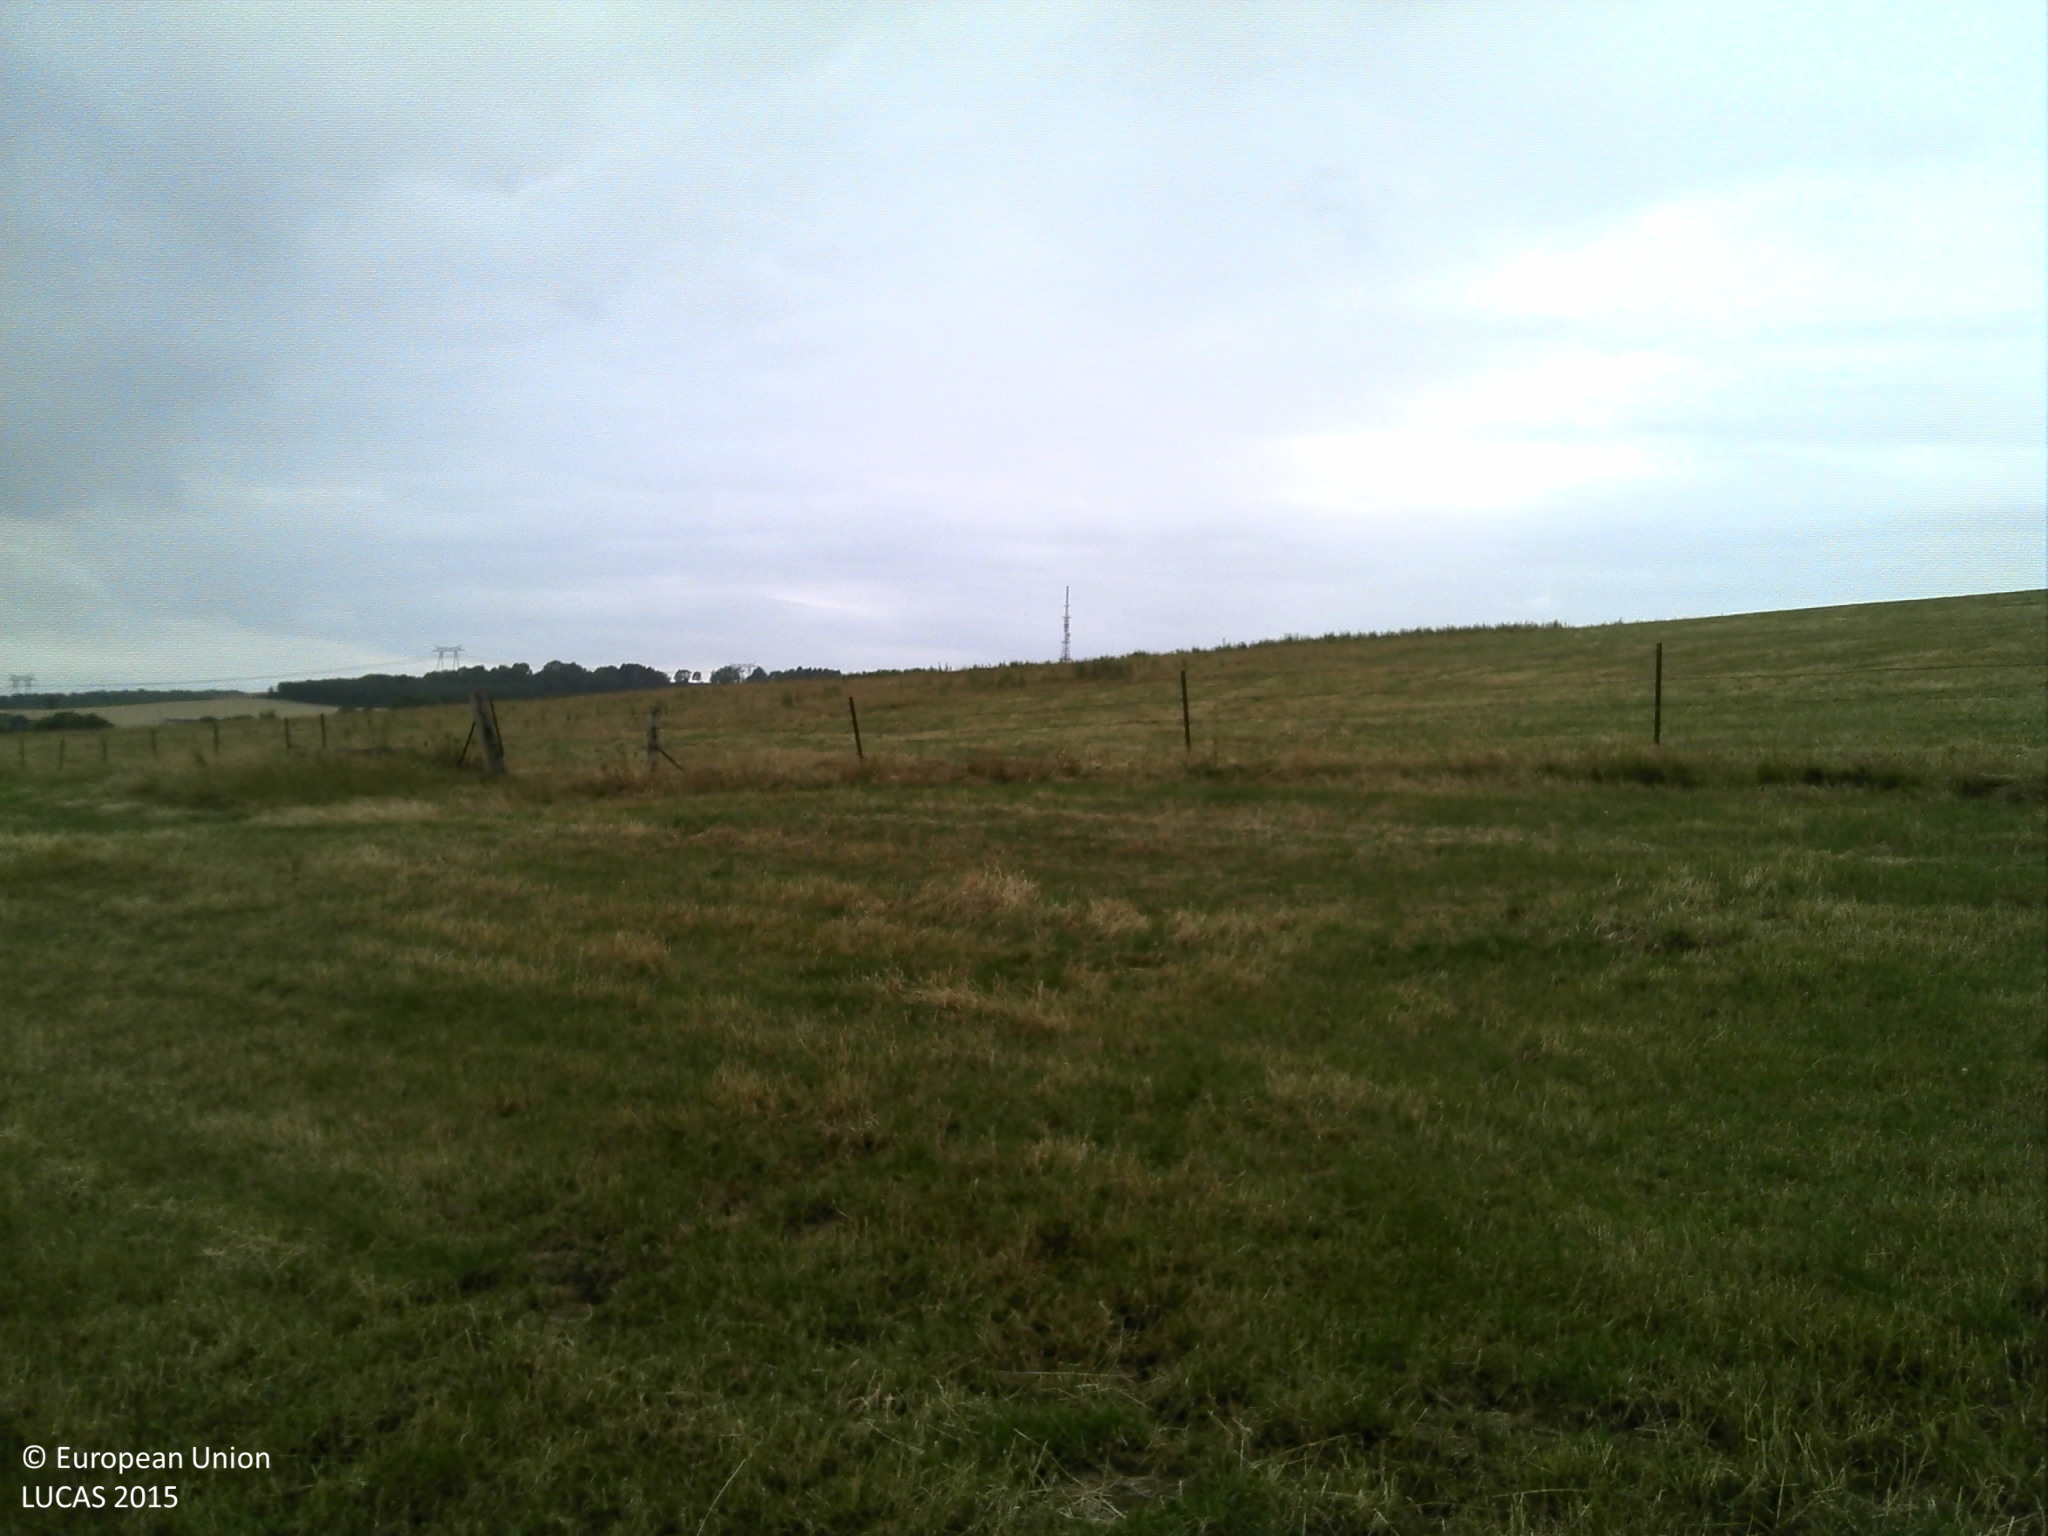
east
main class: Grassland
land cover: Grassland without tree/shrub cover
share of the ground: > 75 %
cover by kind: herbaceous plants 100 %
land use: Agriculture (excluding fallow land and kitchen gardens)
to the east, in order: Grassland without tree/shrub cover
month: July
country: FR
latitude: 49.7691
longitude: 4.6231
